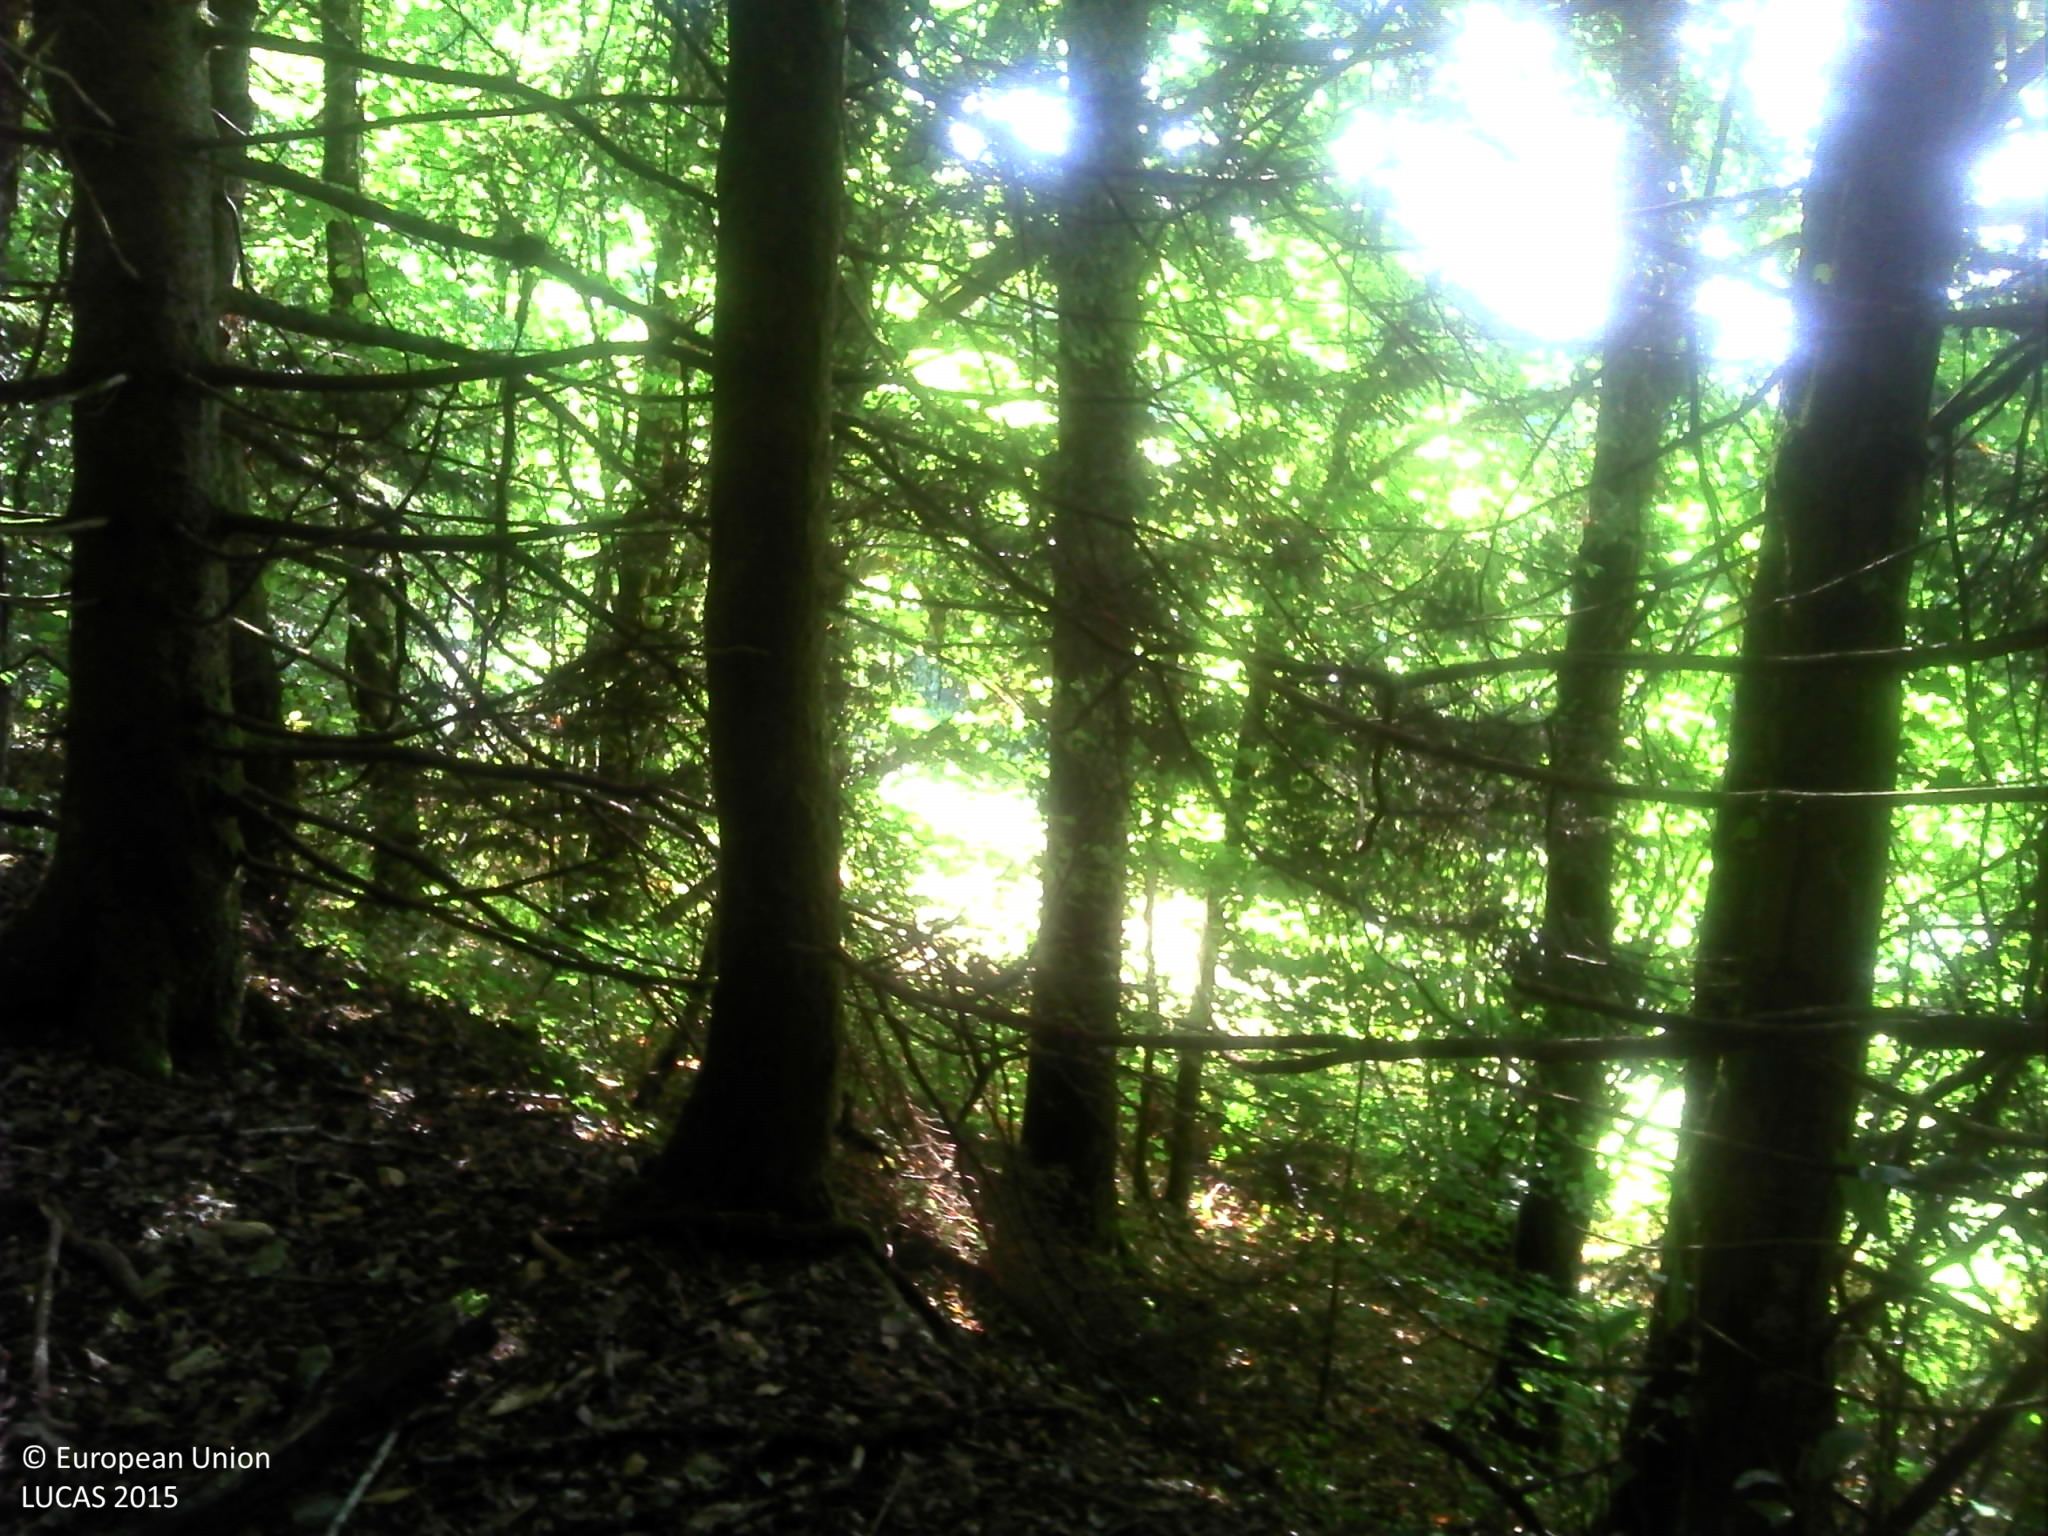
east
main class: Woodland
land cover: Spruce dominated mixed woodland
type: thermophilous deciduous forest
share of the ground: 50 - 75 %
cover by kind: coniferous forest trees 65 %, broadleaved forest trees 25 %, herbaceous plants 5 %, lichens and mosses 5 %
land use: Forestry
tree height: > 5 m
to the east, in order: Spruce dominated mixed woodland; Grassland without tree/shrub cover; Fences; Spruce dominated mixed woodland; Rivers and streams; Spruce dominated mixed woodland; Rivers and streams; Spruce dominated mixed woodland; Fences; Grassland without tree/shrub cover
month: July
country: FR
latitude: 45.6156
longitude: 1.7487
